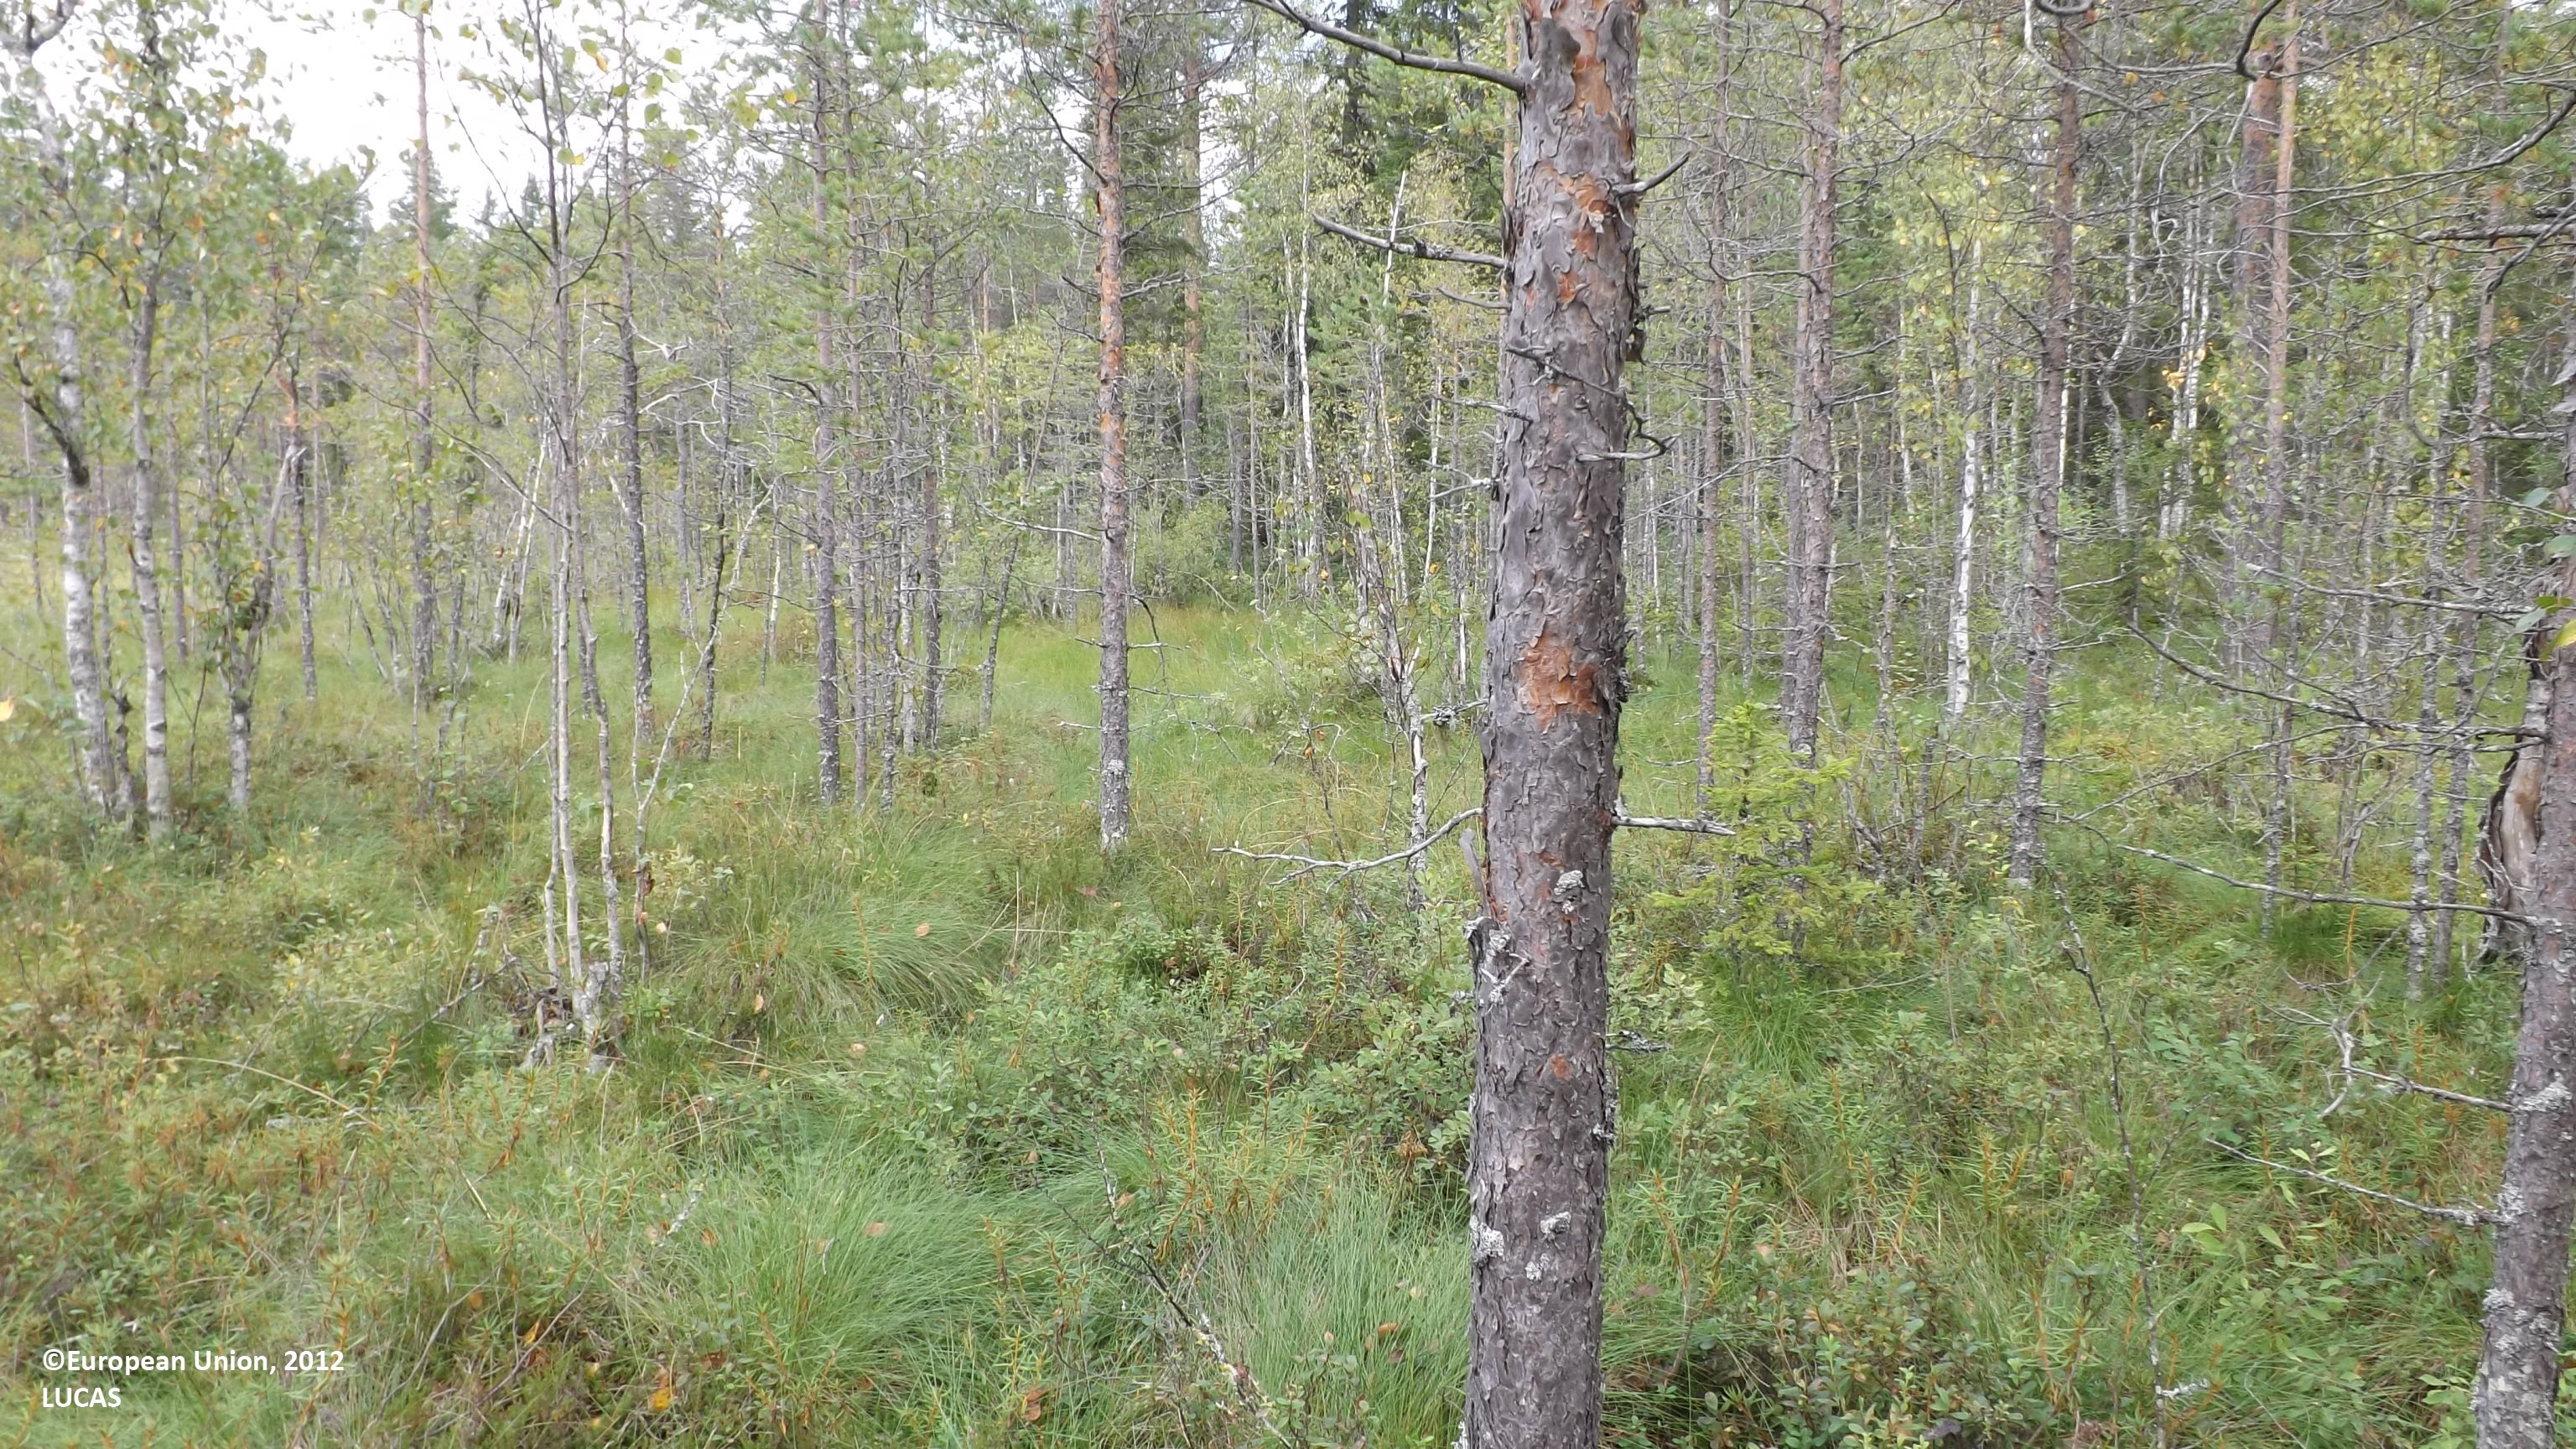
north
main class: Woodland
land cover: Pine dominated mixed woodland
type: mire and swamp forests
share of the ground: 25 - 50 %
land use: Semi-natural and natural areas not in use
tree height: > 5 m
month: August
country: FI
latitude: 63.7030
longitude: 23.9669
